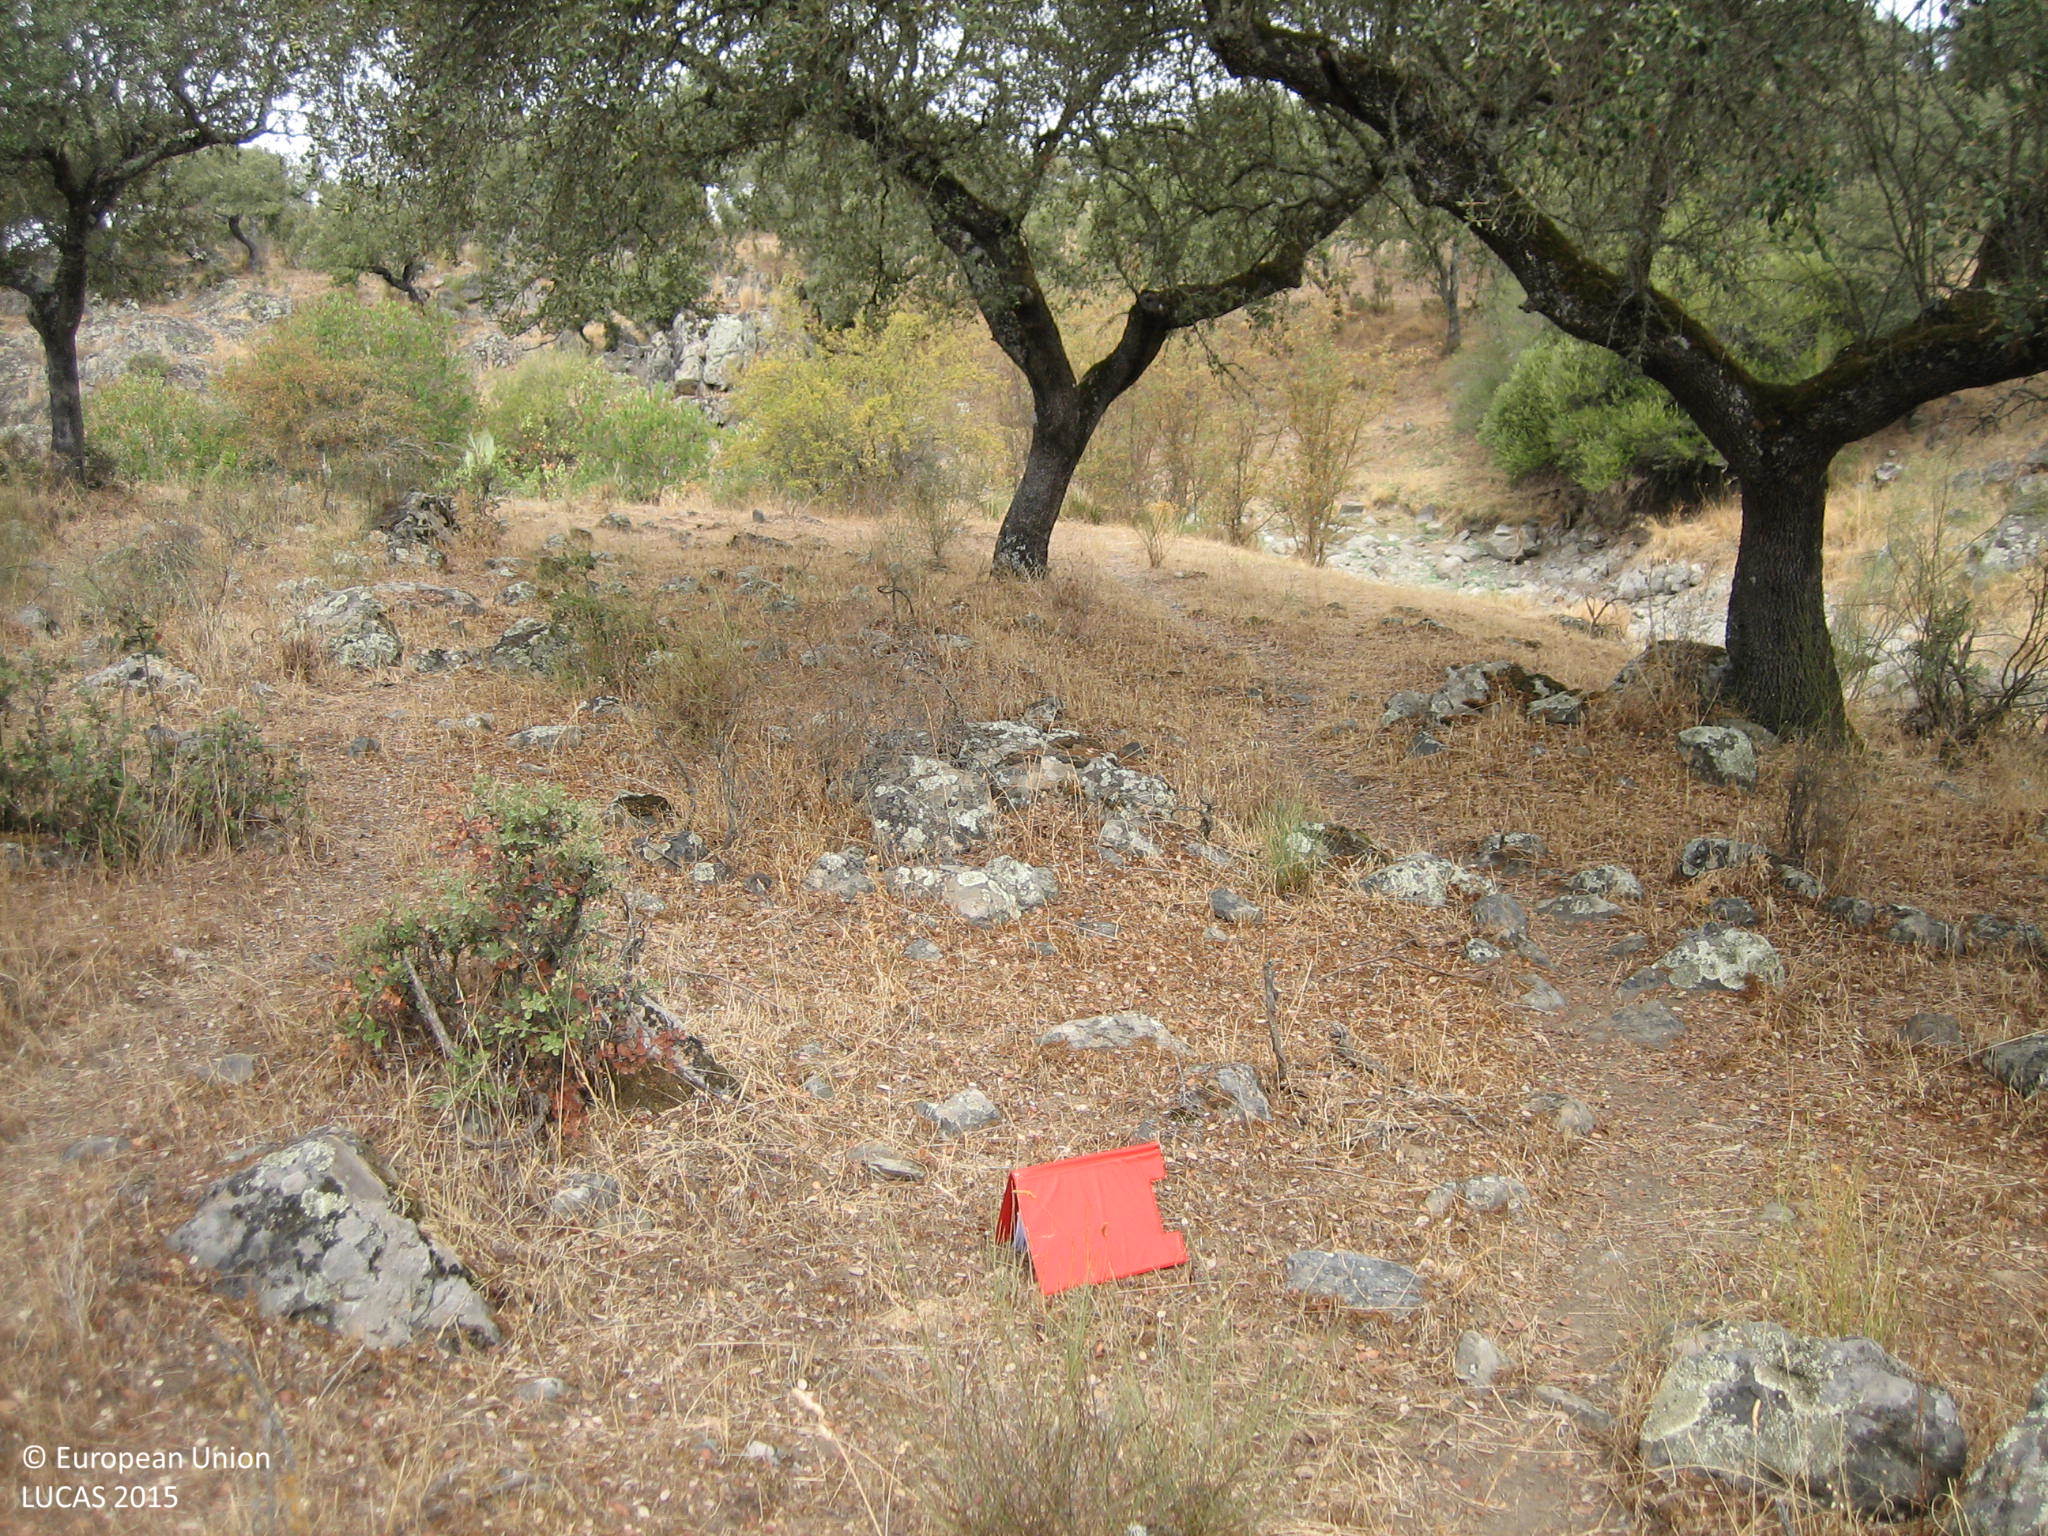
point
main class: Woodland
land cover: Broadleaved woodland
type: broadleaved evergreen forest
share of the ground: 25 - 50 %
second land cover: Shrubland without tree cover
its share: 10 - 25 %
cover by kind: herbaceous plants 55 %, broadleaved forest trees 30 %, shrubs 15 %
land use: Forestry
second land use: Agriculture (excluding fallow land and kitchen gardens)
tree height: > 5 m
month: September
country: ES
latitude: 38.5639
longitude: -6.9221
